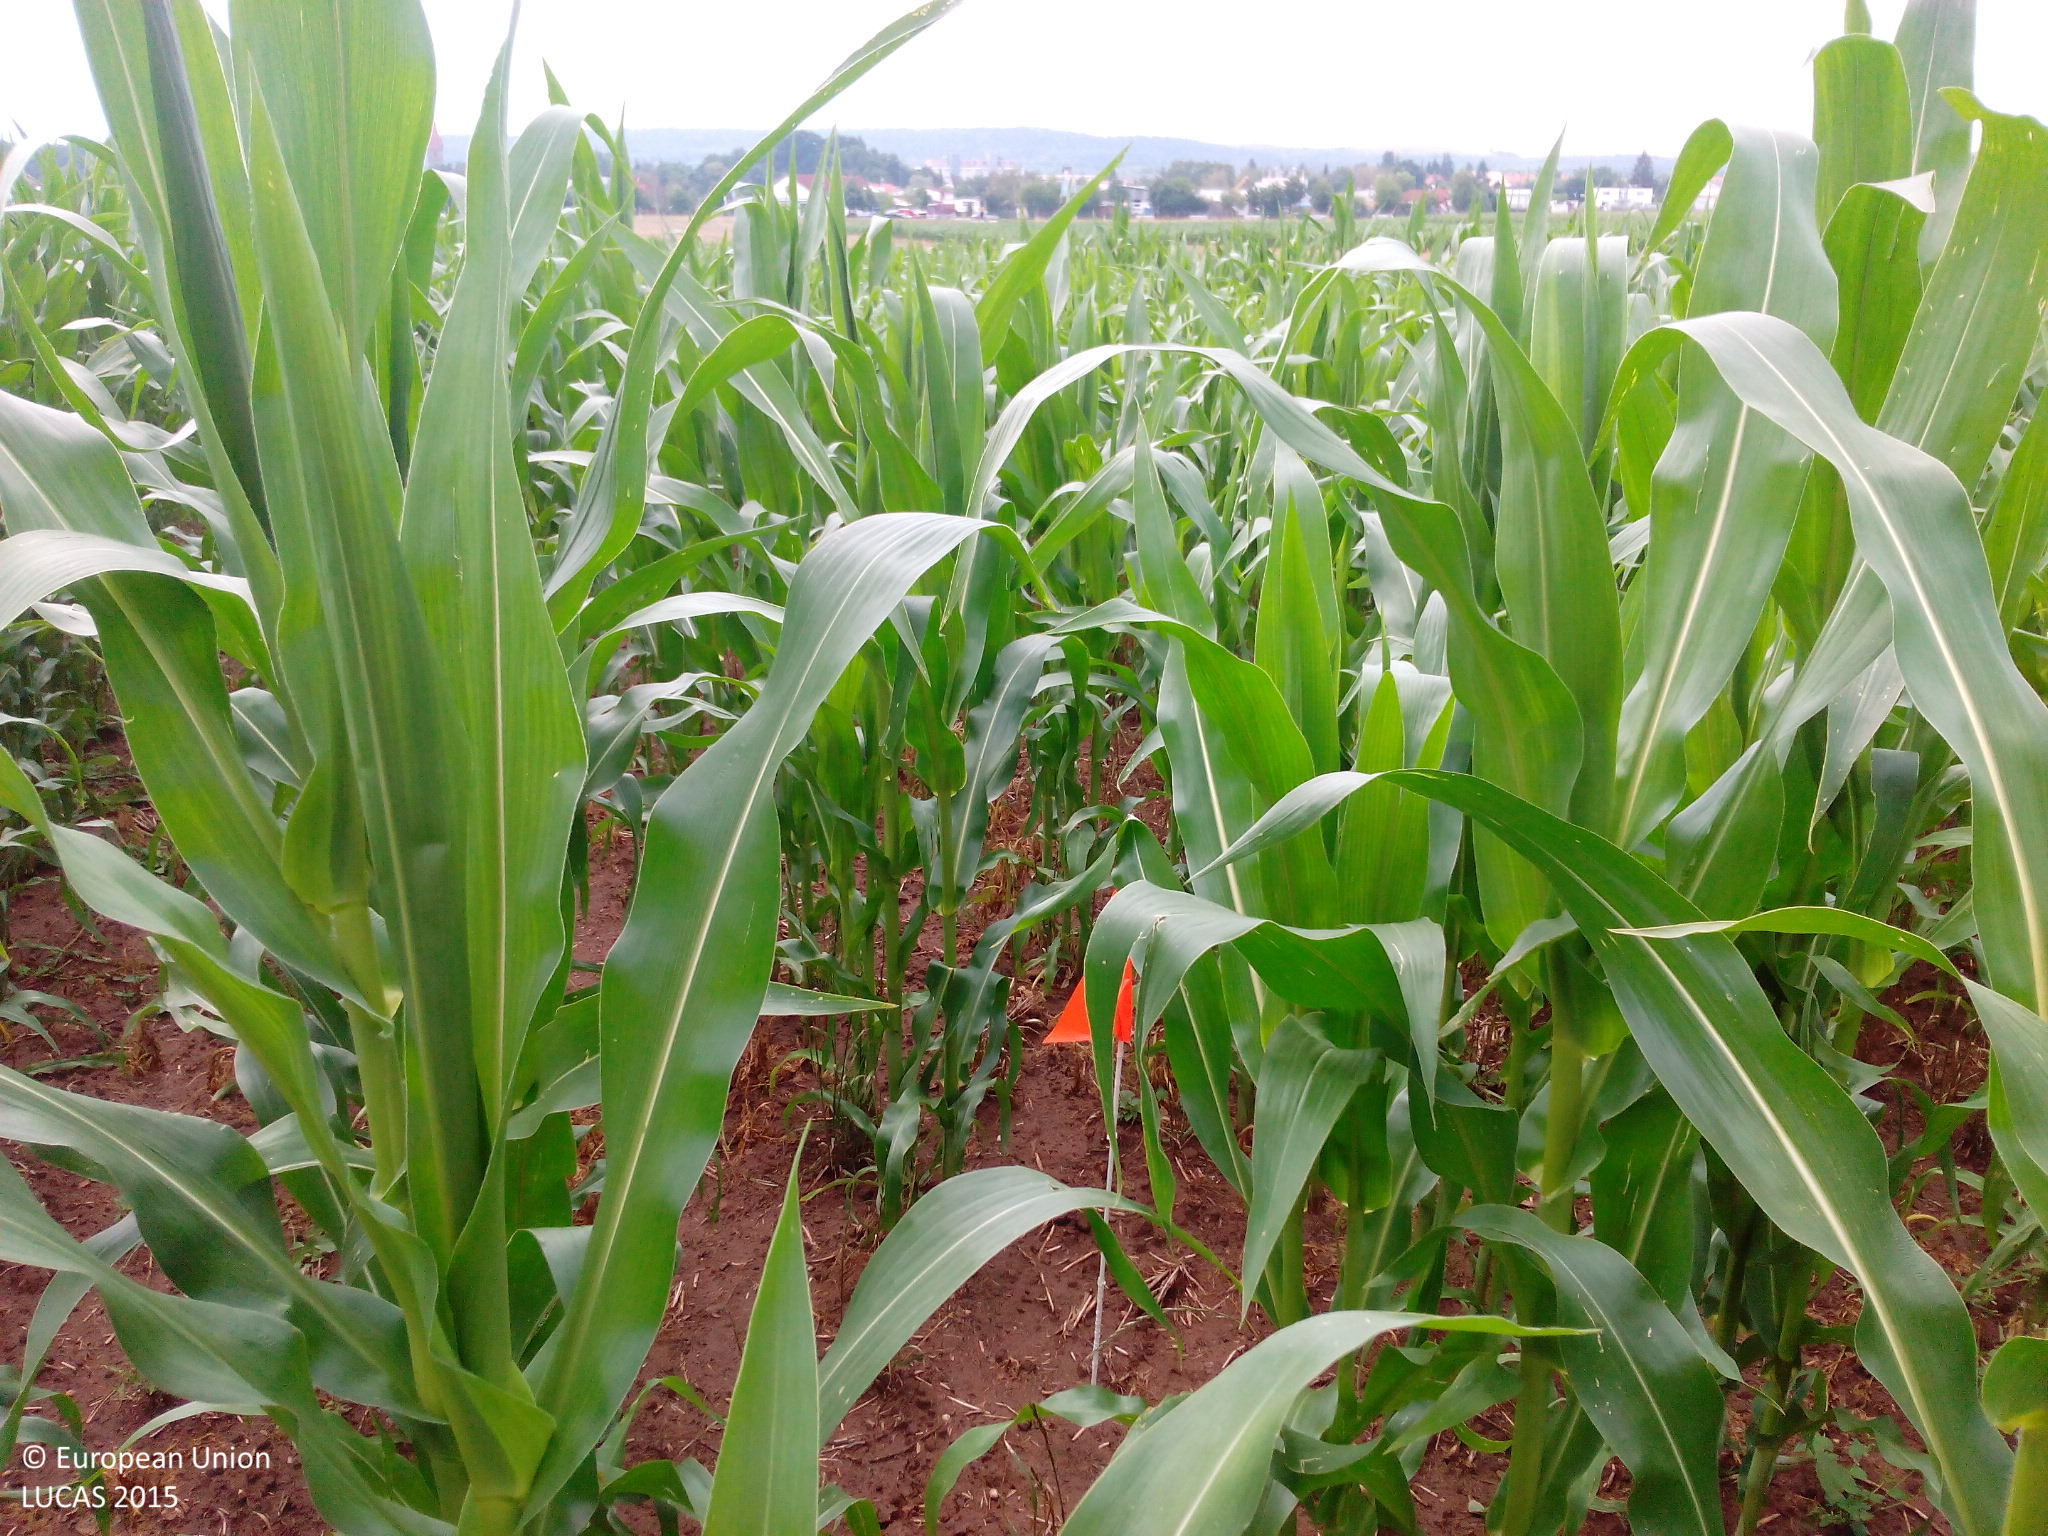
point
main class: Cropland
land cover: Maize
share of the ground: > 75 %
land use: Agriculture (excluding fallow land and kitchen gardens)
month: July
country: DE
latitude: 49.4971
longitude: 10.9247
